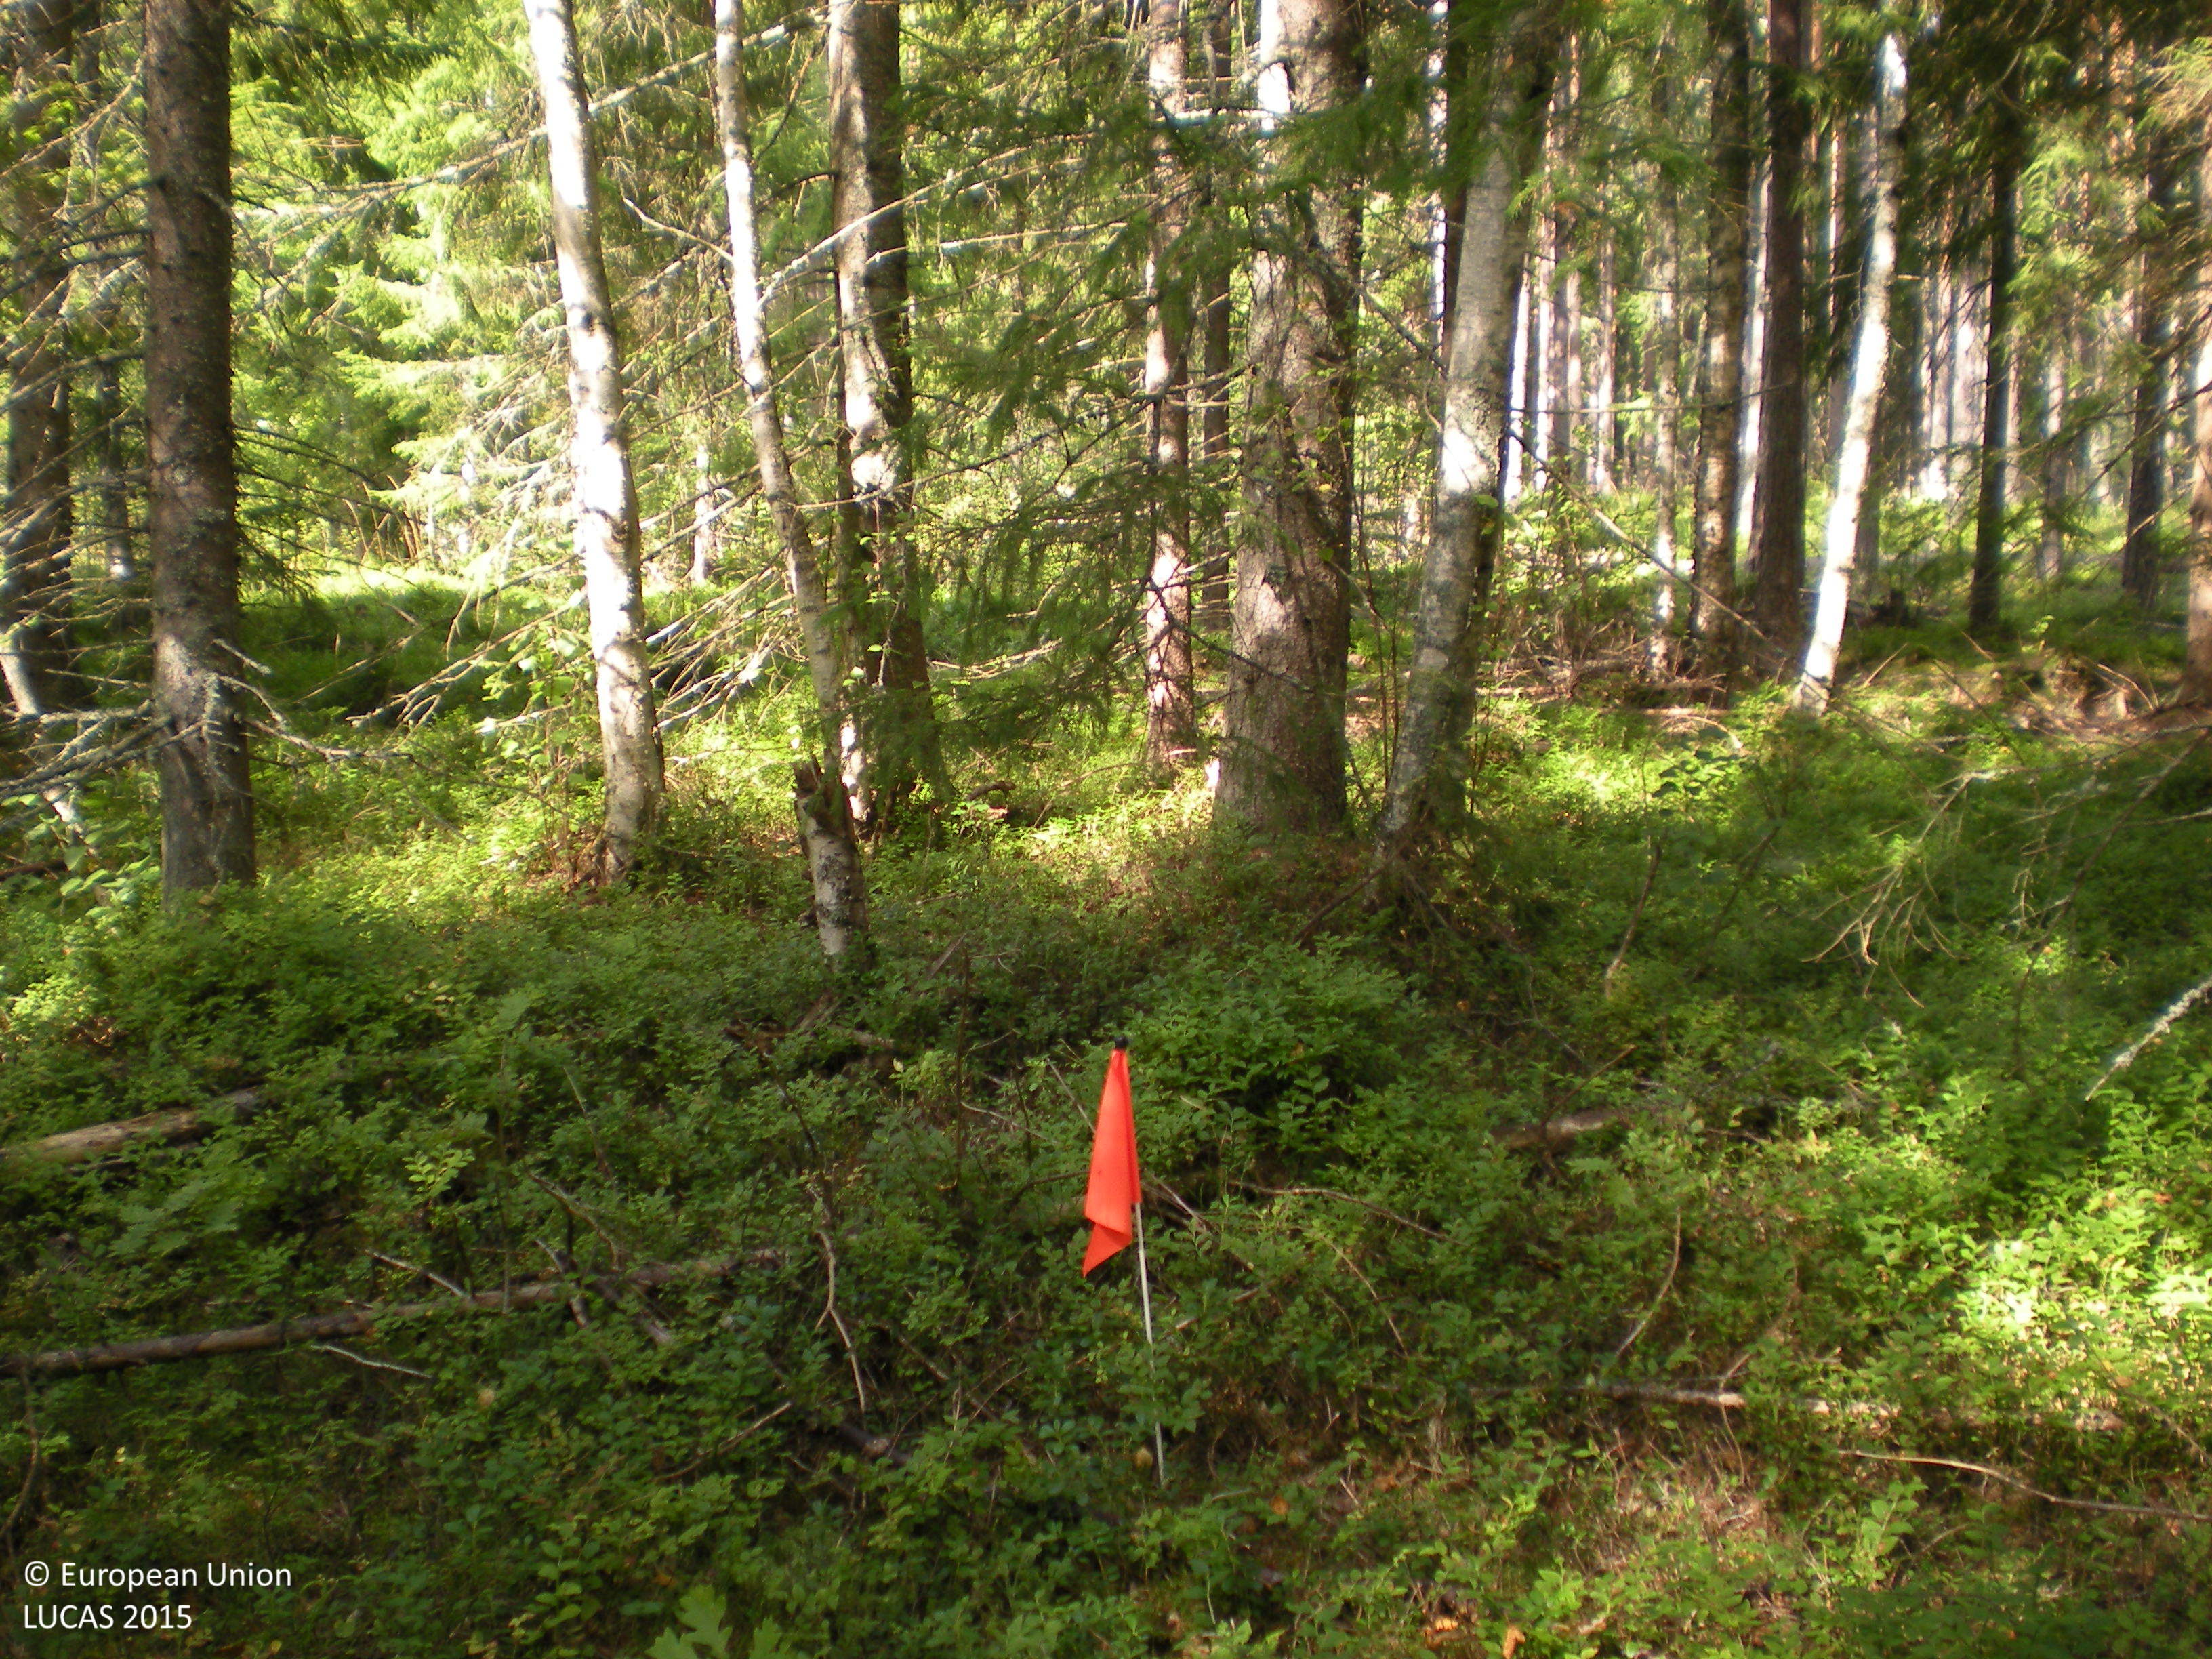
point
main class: Woodland
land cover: Spruce dominated mixed woodland
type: boreal forest
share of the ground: 50 - 75 %
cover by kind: coniferous forest trees 50 %, broadleaved forest trees 20 %, shrubs 20 %, herbaceous plants 5 %, lichens and mosses 5 %
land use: Forestry
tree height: > 5 m
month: August
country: SE
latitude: 60.4646
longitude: 17.2464
